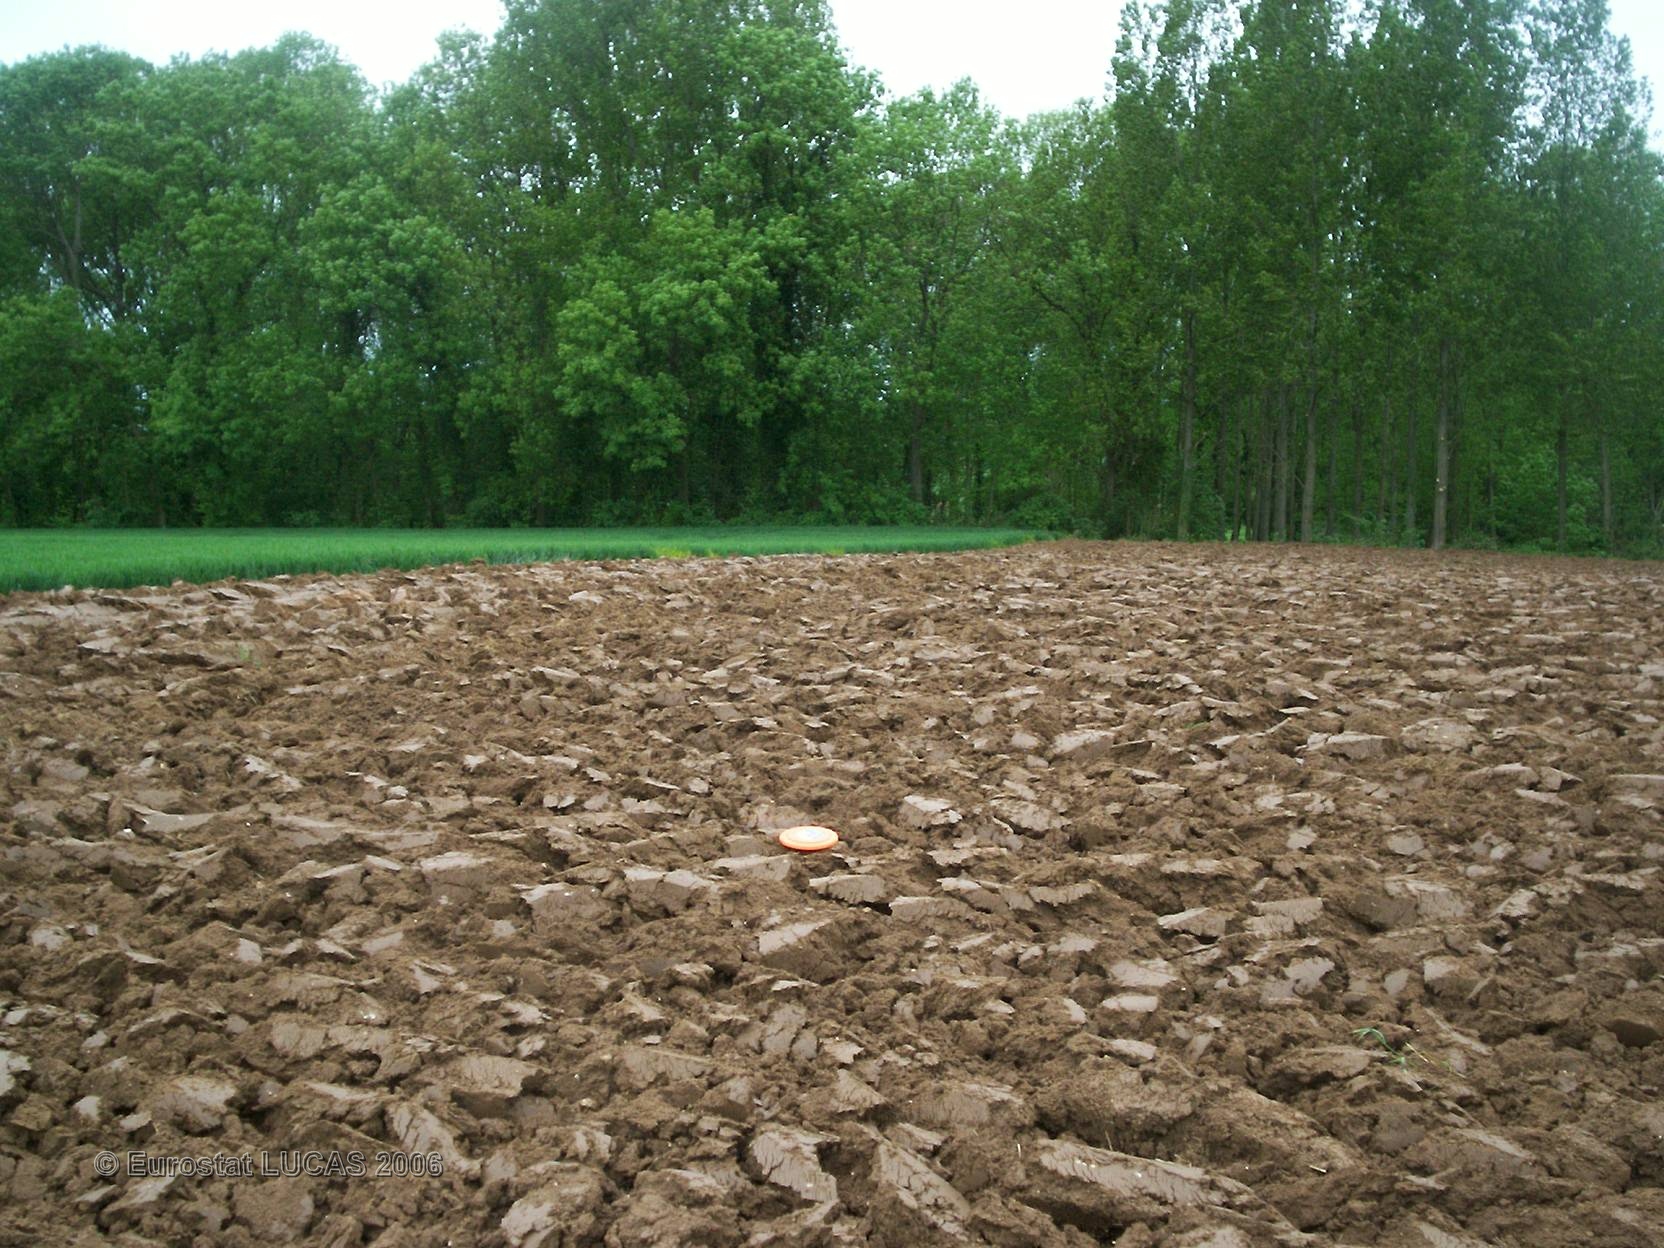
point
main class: Cropland
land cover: Maize
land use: Agriculture (excluding fallow land and kitchen gardens)
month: June
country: FR
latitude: 50.2844
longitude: 2.5636
